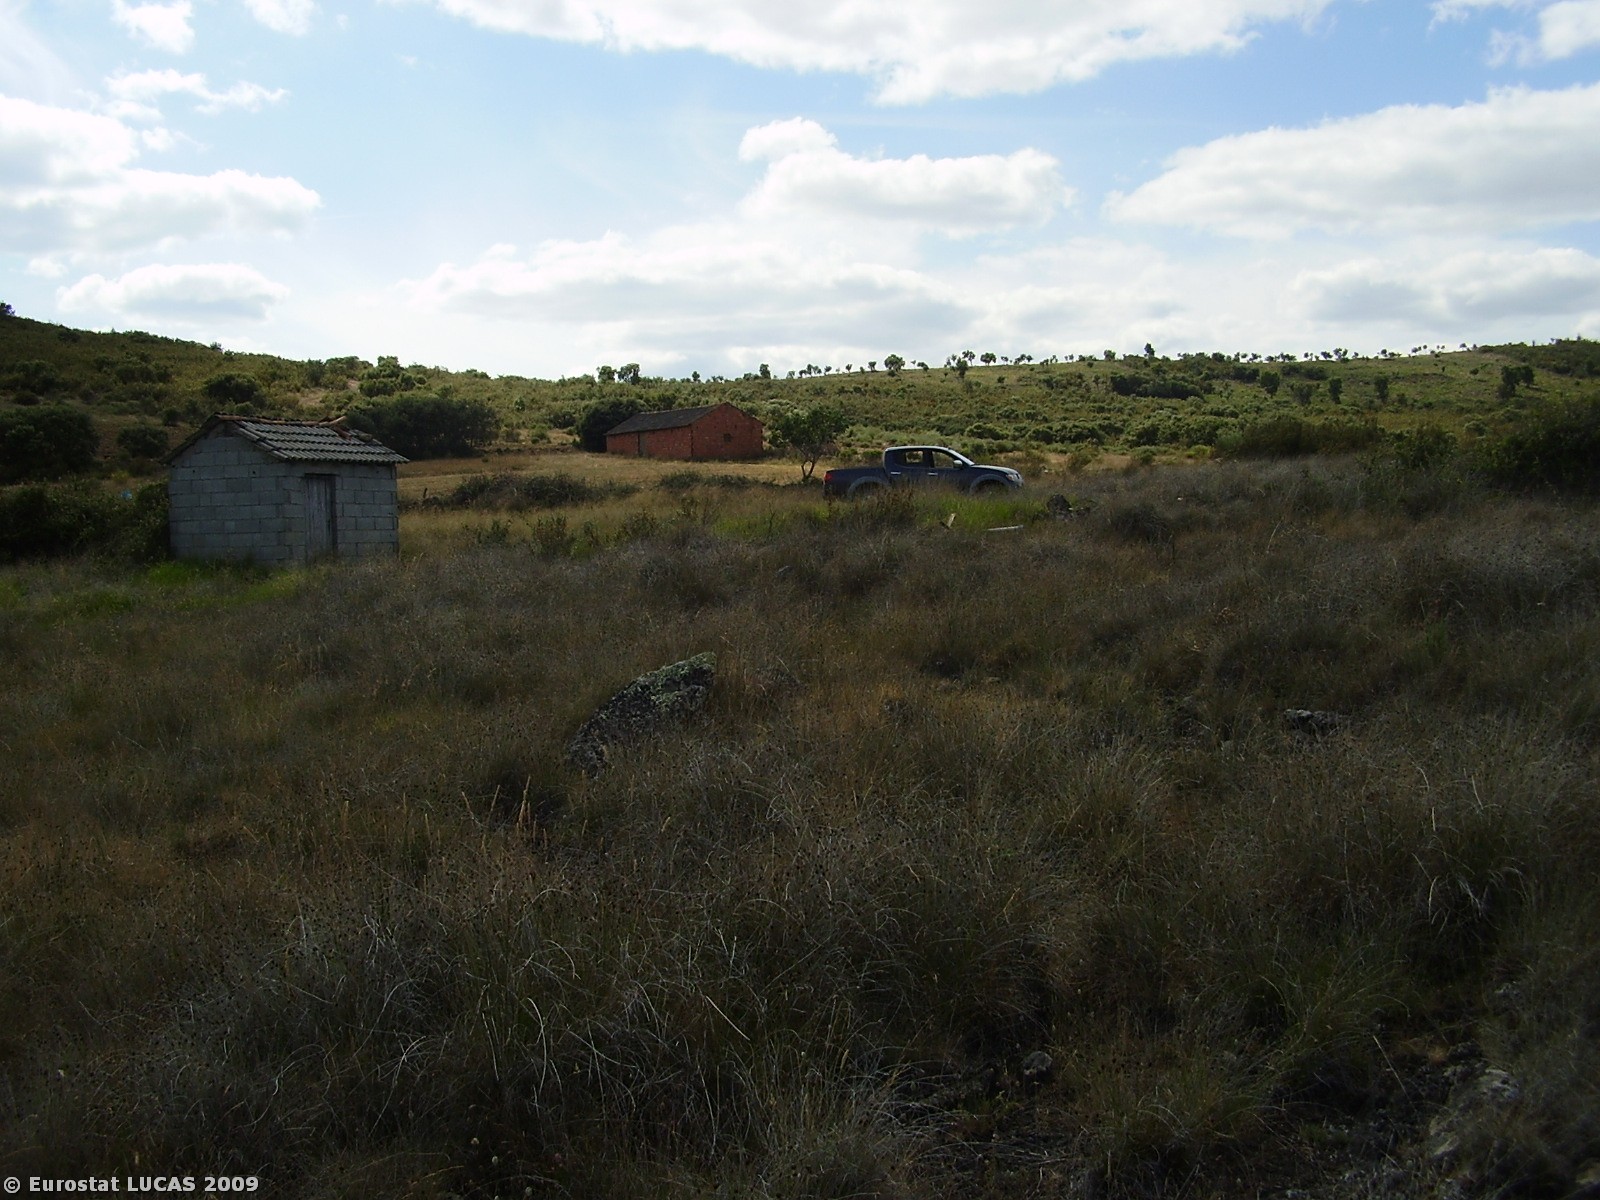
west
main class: Grassland
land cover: Spontaneously vegetated surfaces
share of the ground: > 75 %
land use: Fallow land
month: June
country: PT
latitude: 41.5013
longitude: -6.7729
